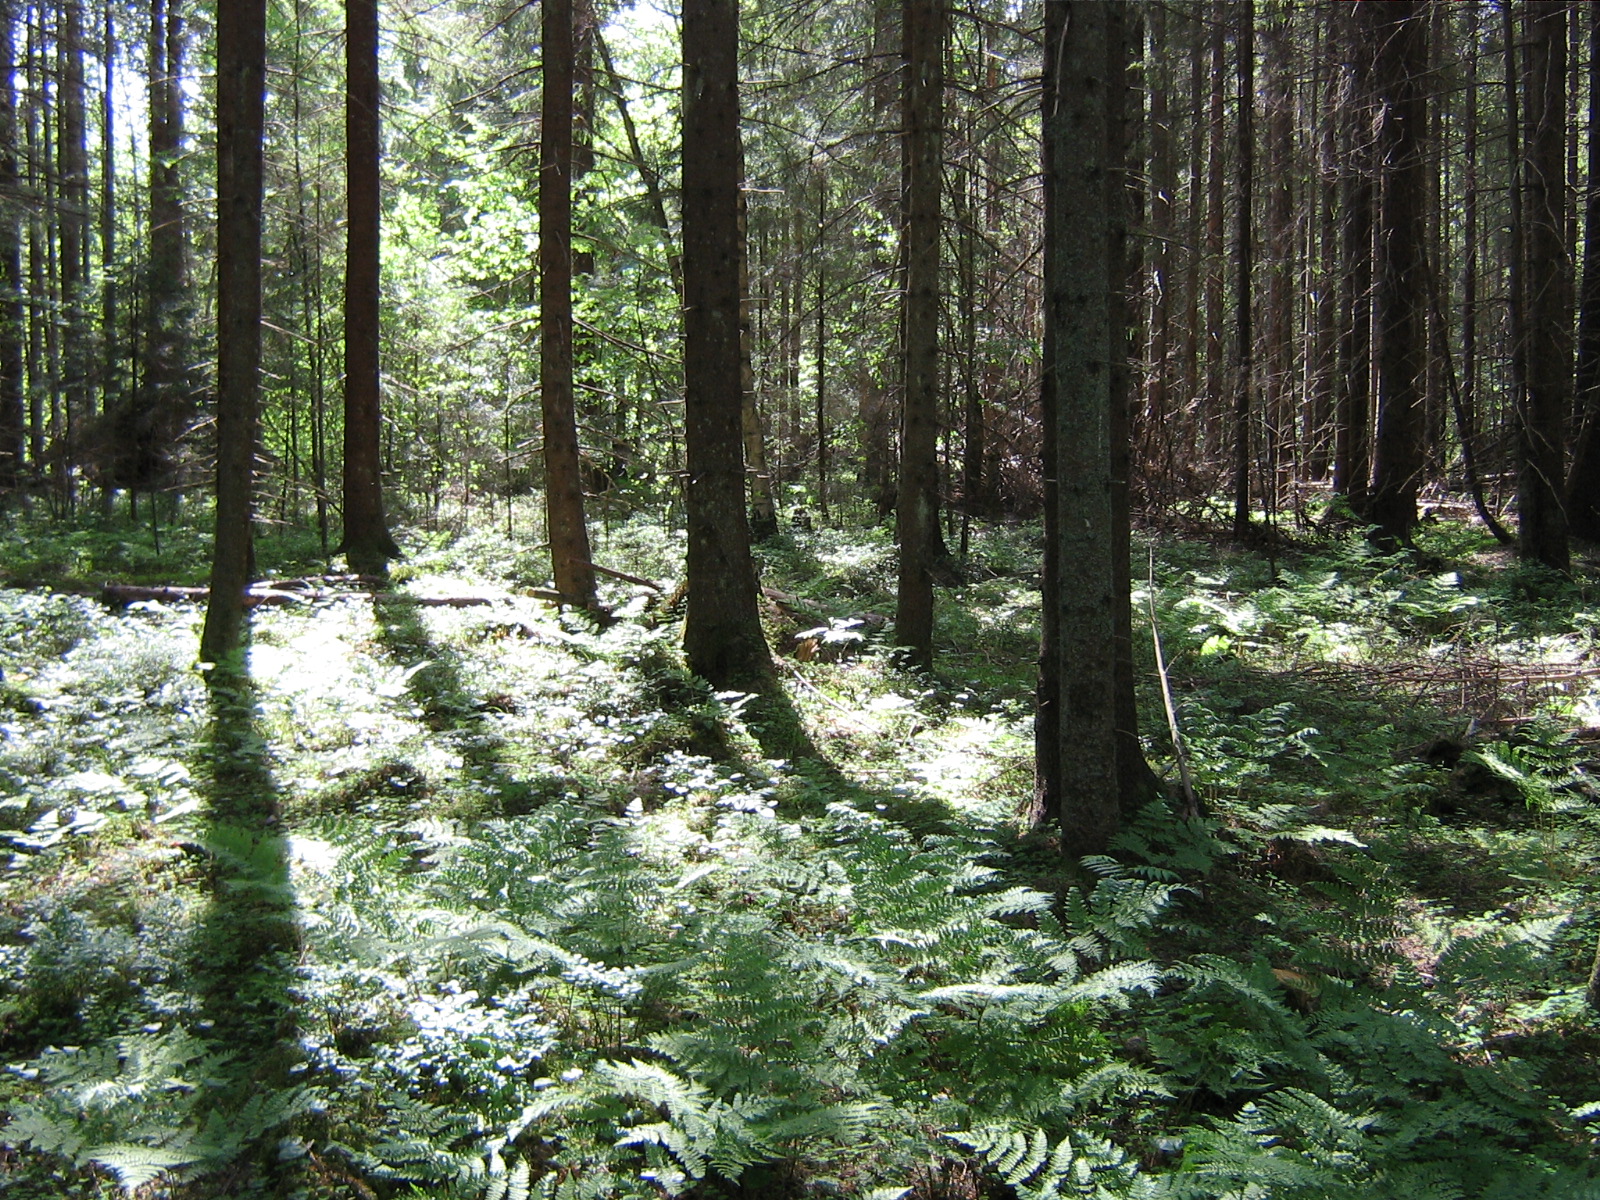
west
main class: Woodland
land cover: Spruce dominated coniferous woodland
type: hemiboreal forest and nemoral coniferous forest and mixed broadleaved-coniferous forest
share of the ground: > 75 %
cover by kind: coniferous forest trees 100 %
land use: Forestry
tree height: > 5 m
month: June
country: LV
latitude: 57.0779
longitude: 25.3063
